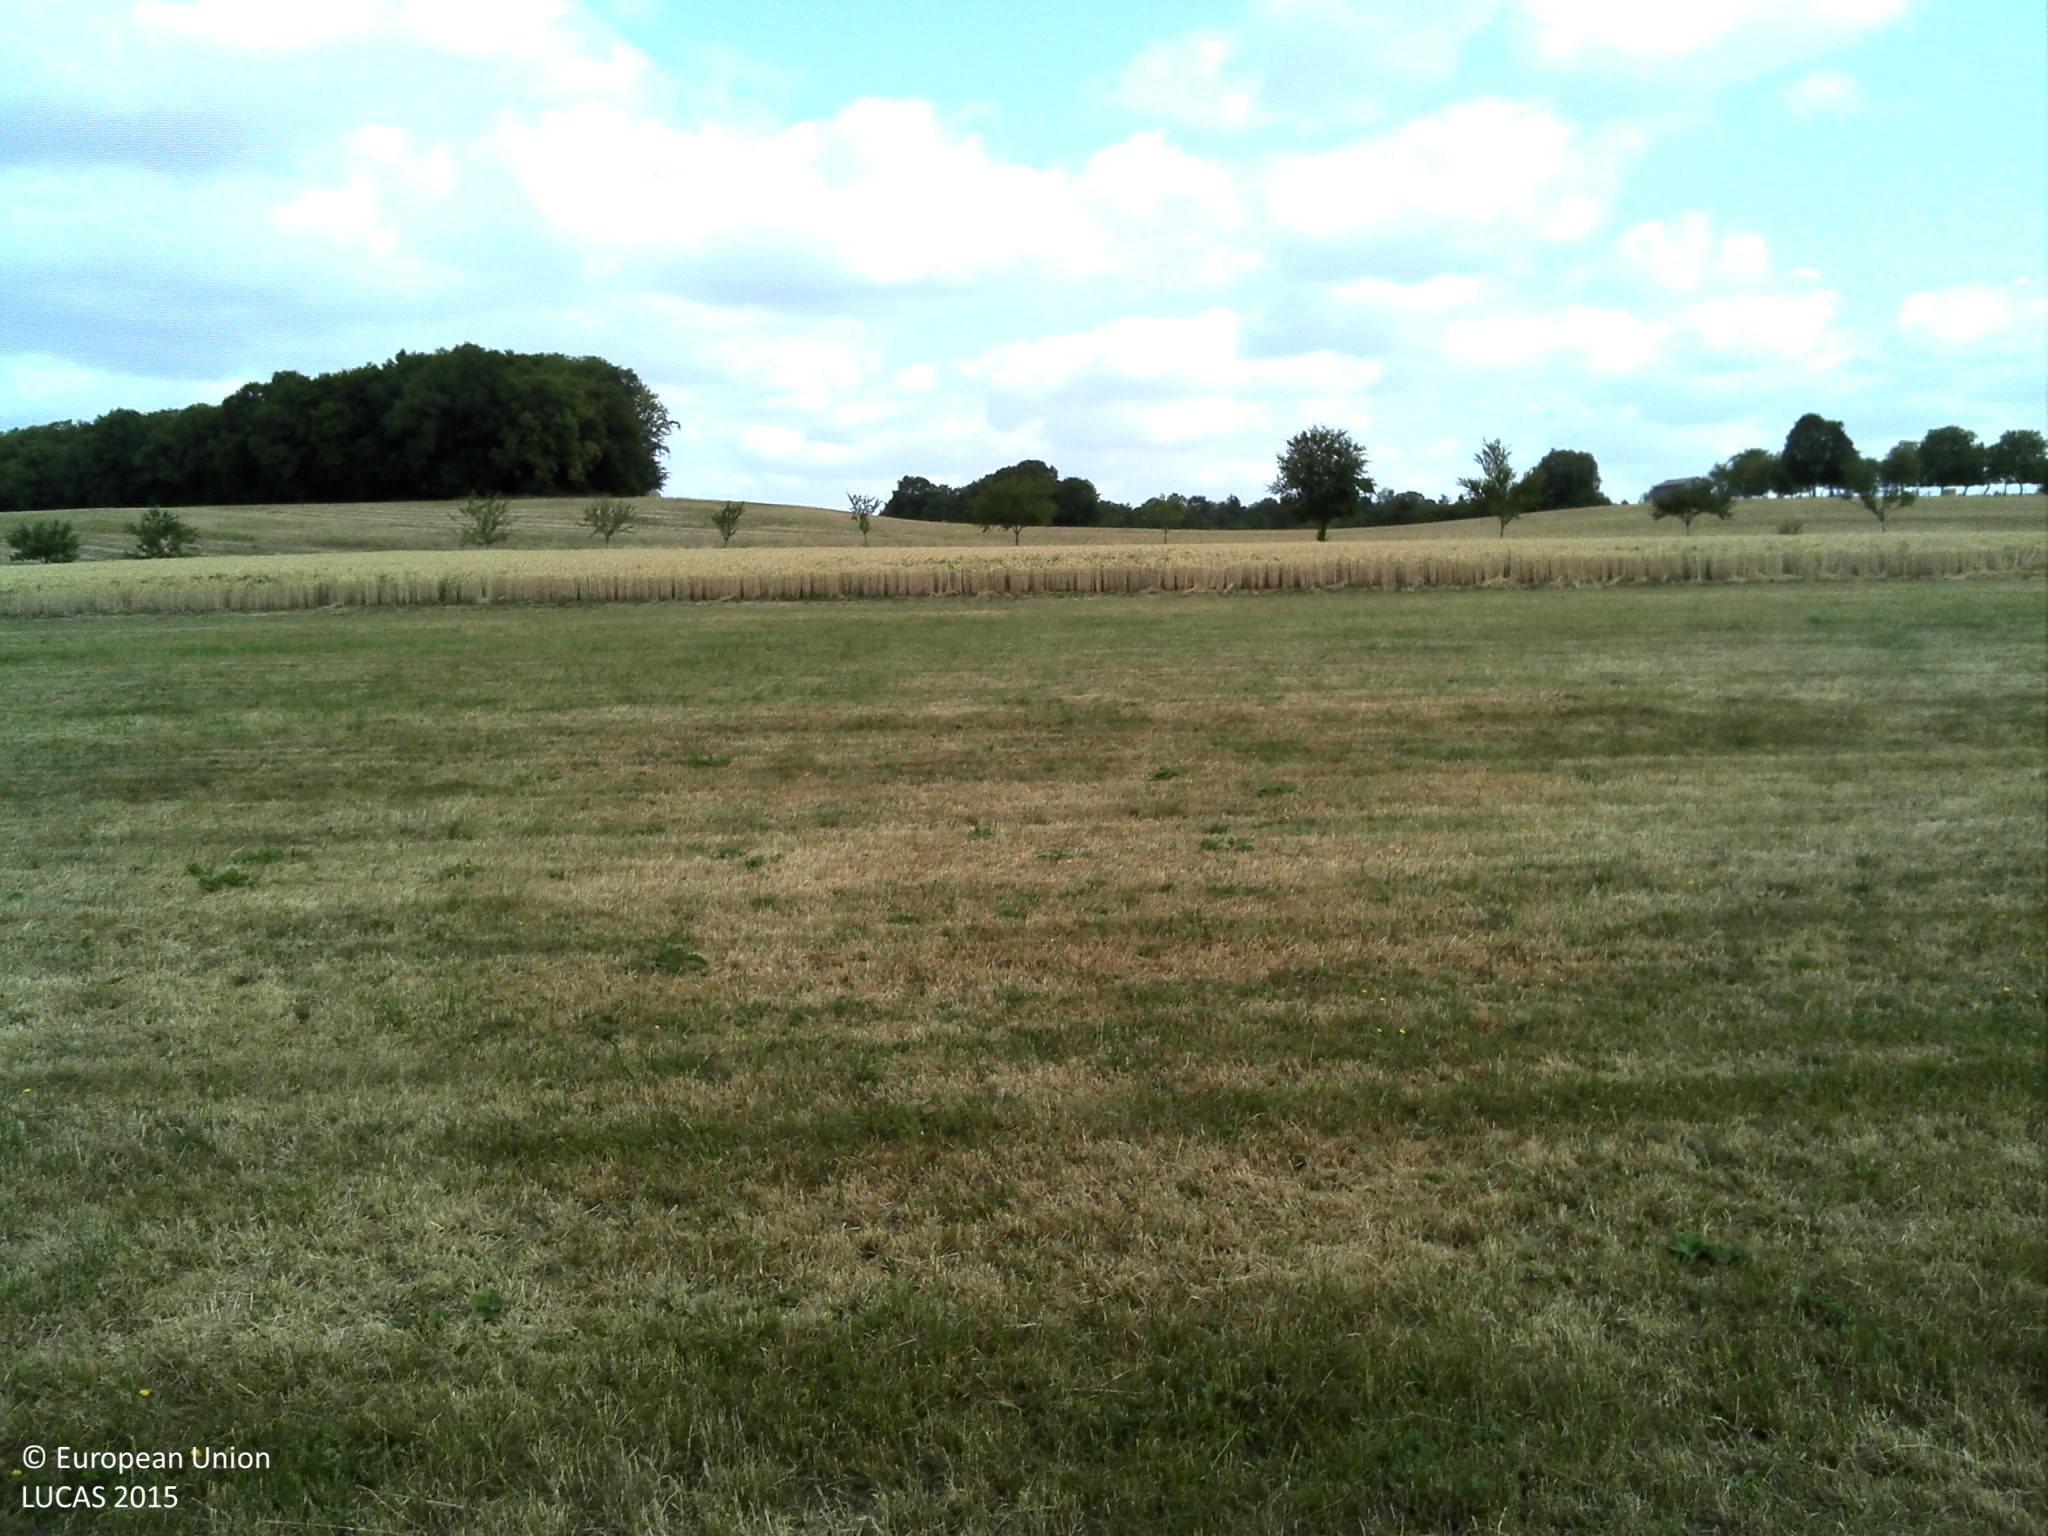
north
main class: Grassland
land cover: Grassland without tree/shrub cover
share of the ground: > 75 %
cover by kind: herbaceous plants 100 %
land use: Agriculture (excluding fallow land and kitchen gardens)
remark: Harvested field
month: July
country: FR
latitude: 48.1759
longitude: 6.1947
